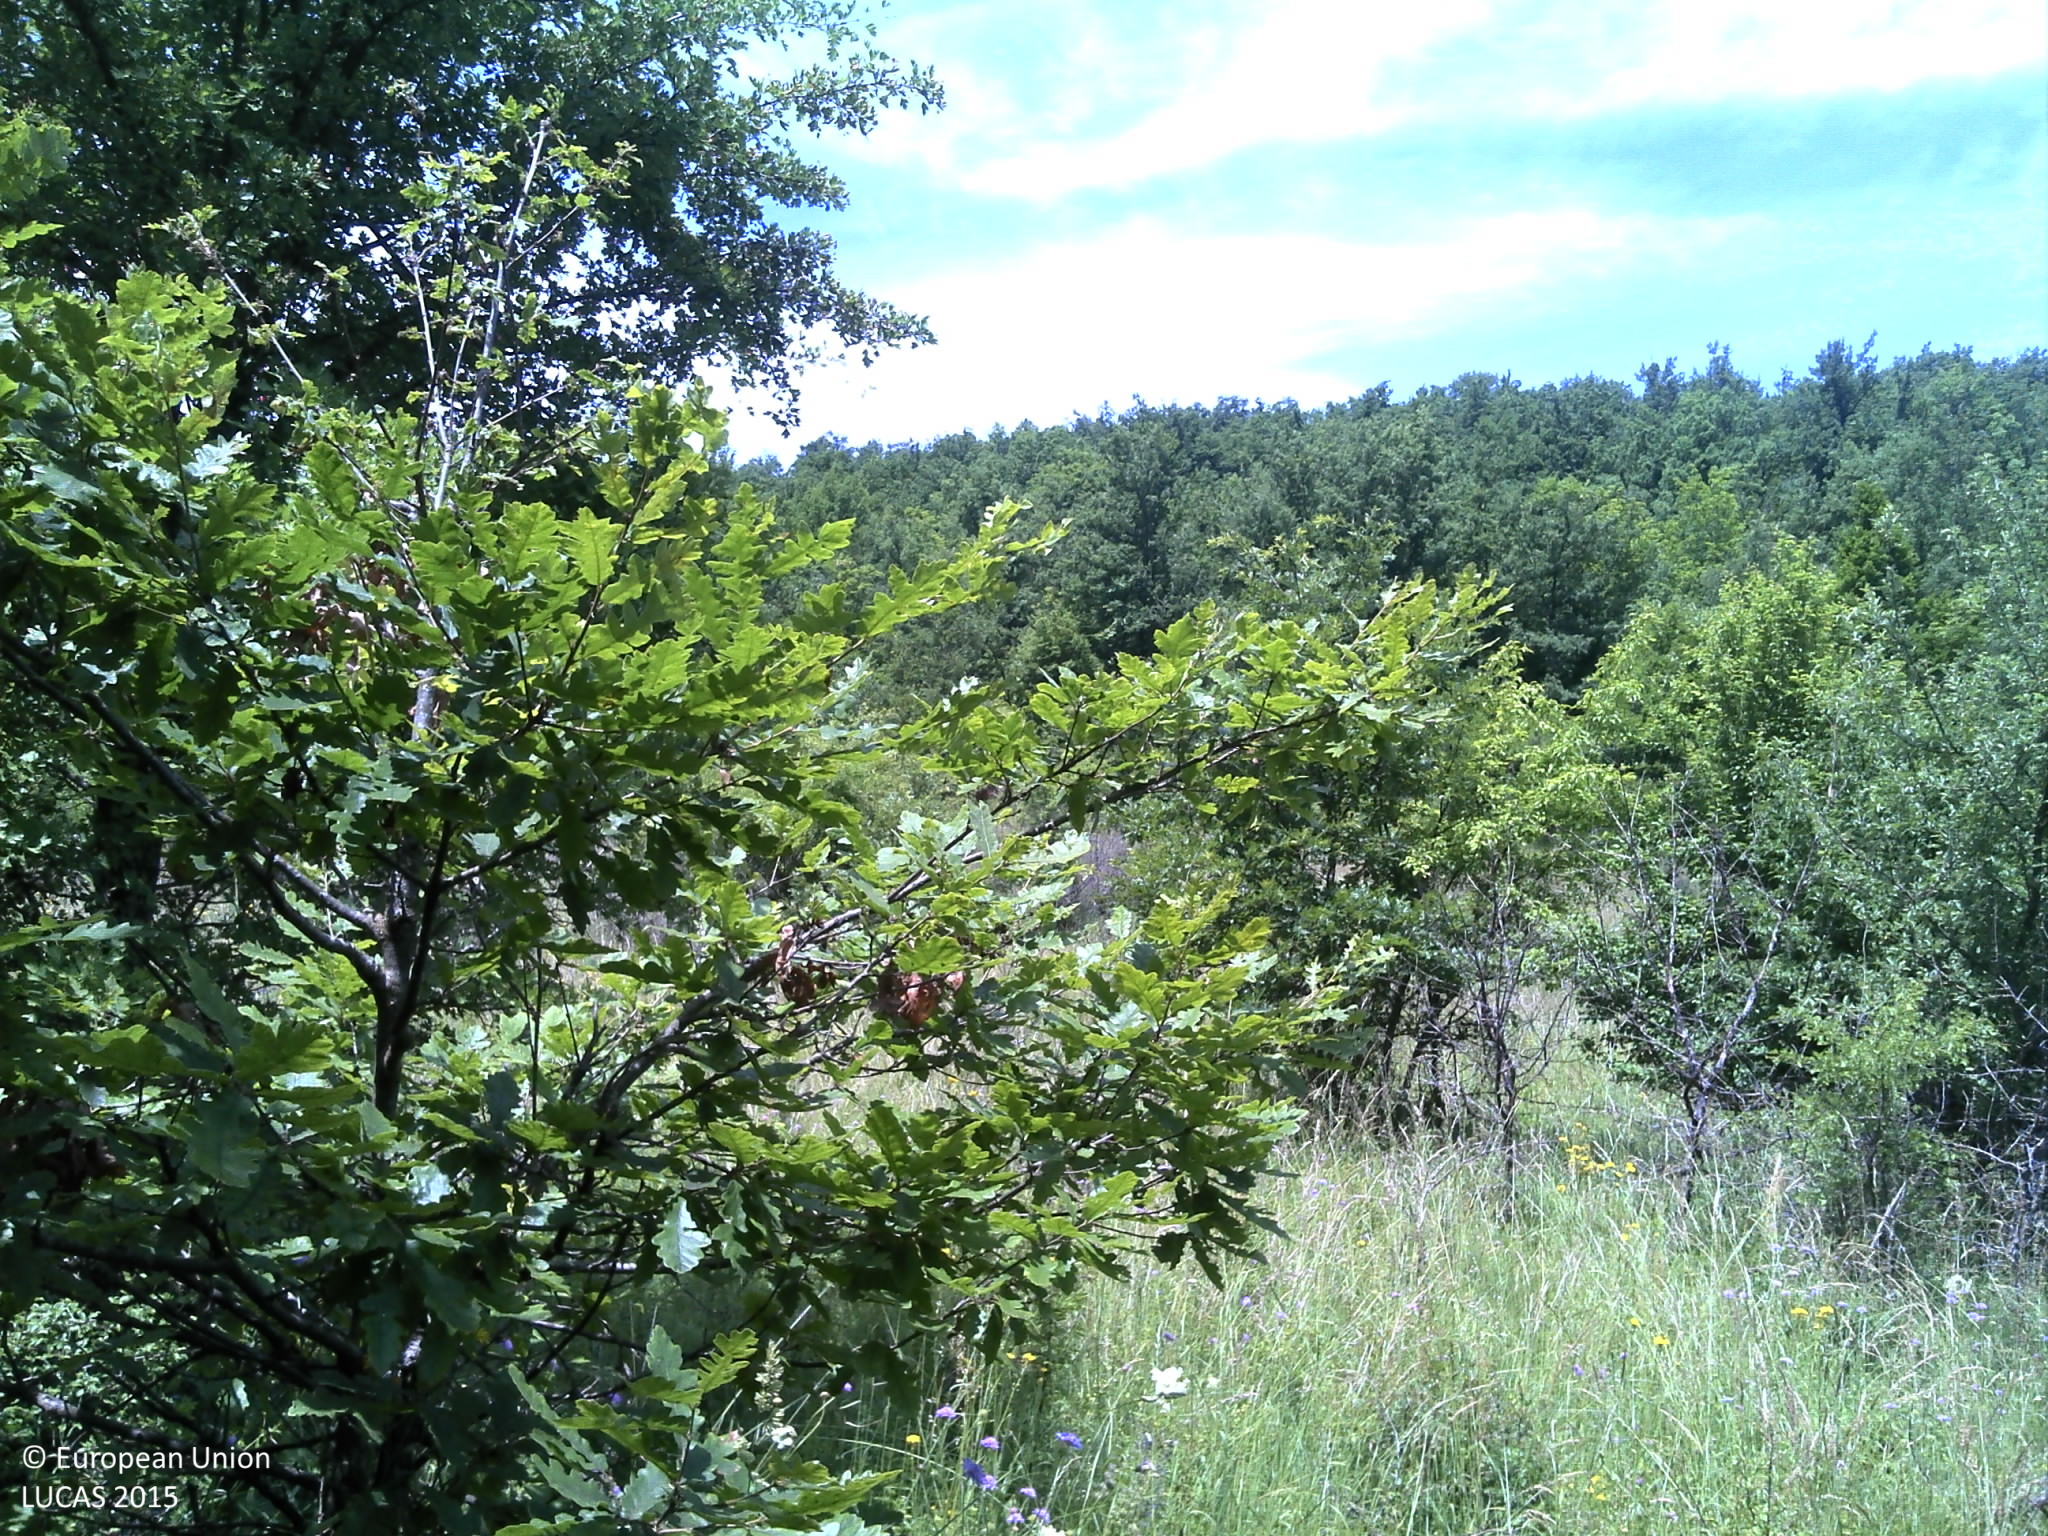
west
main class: Woodland
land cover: Broadleaved woodland
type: beech forest
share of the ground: > 75 %
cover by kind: broadleaved forest trees 95 %, herbaceous plants 5 %
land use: Semi-natural and natural areas not in use
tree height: > 5 m
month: June
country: HR
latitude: 44.5358
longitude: 16.0473
